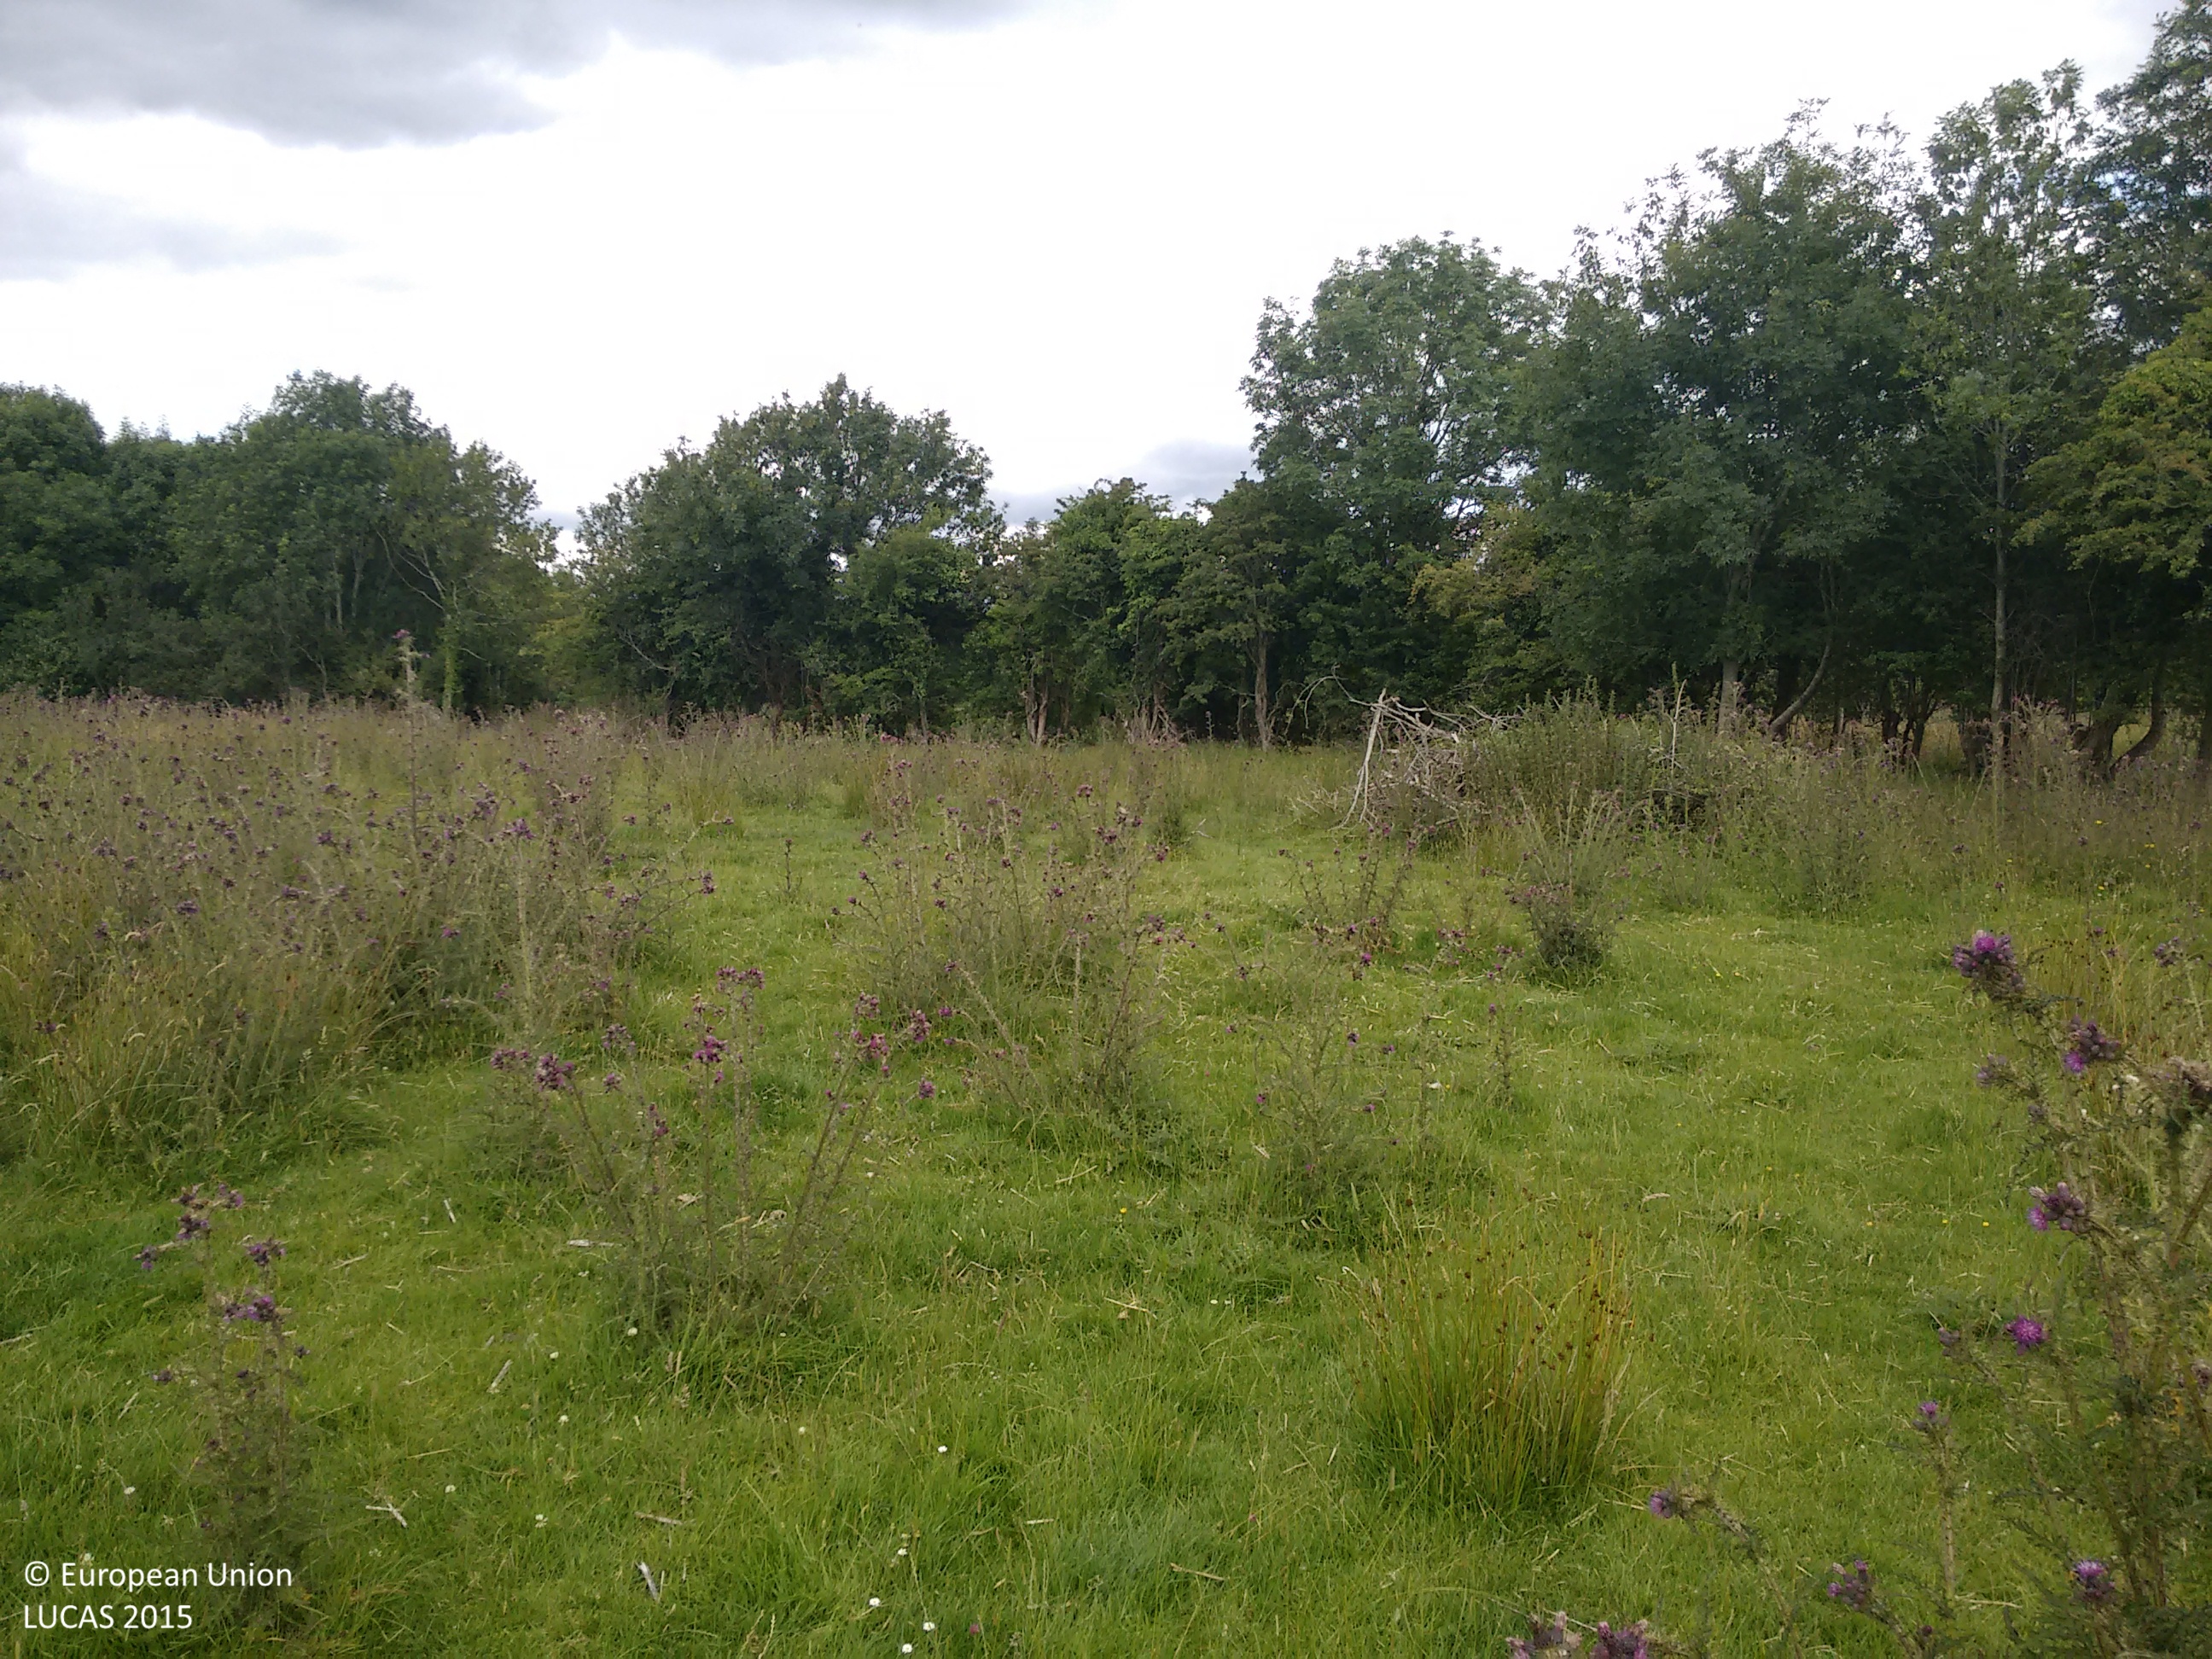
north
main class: Grassland
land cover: Grassland without tree/shrub cover
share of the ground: > 75 %
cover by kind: herbaceous plants 95 %, shrubs 5 %
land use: Agriculture (excluding fallow land and kitchen gardens)
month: July
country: IE
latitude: 53.5544
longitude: -7.8456
